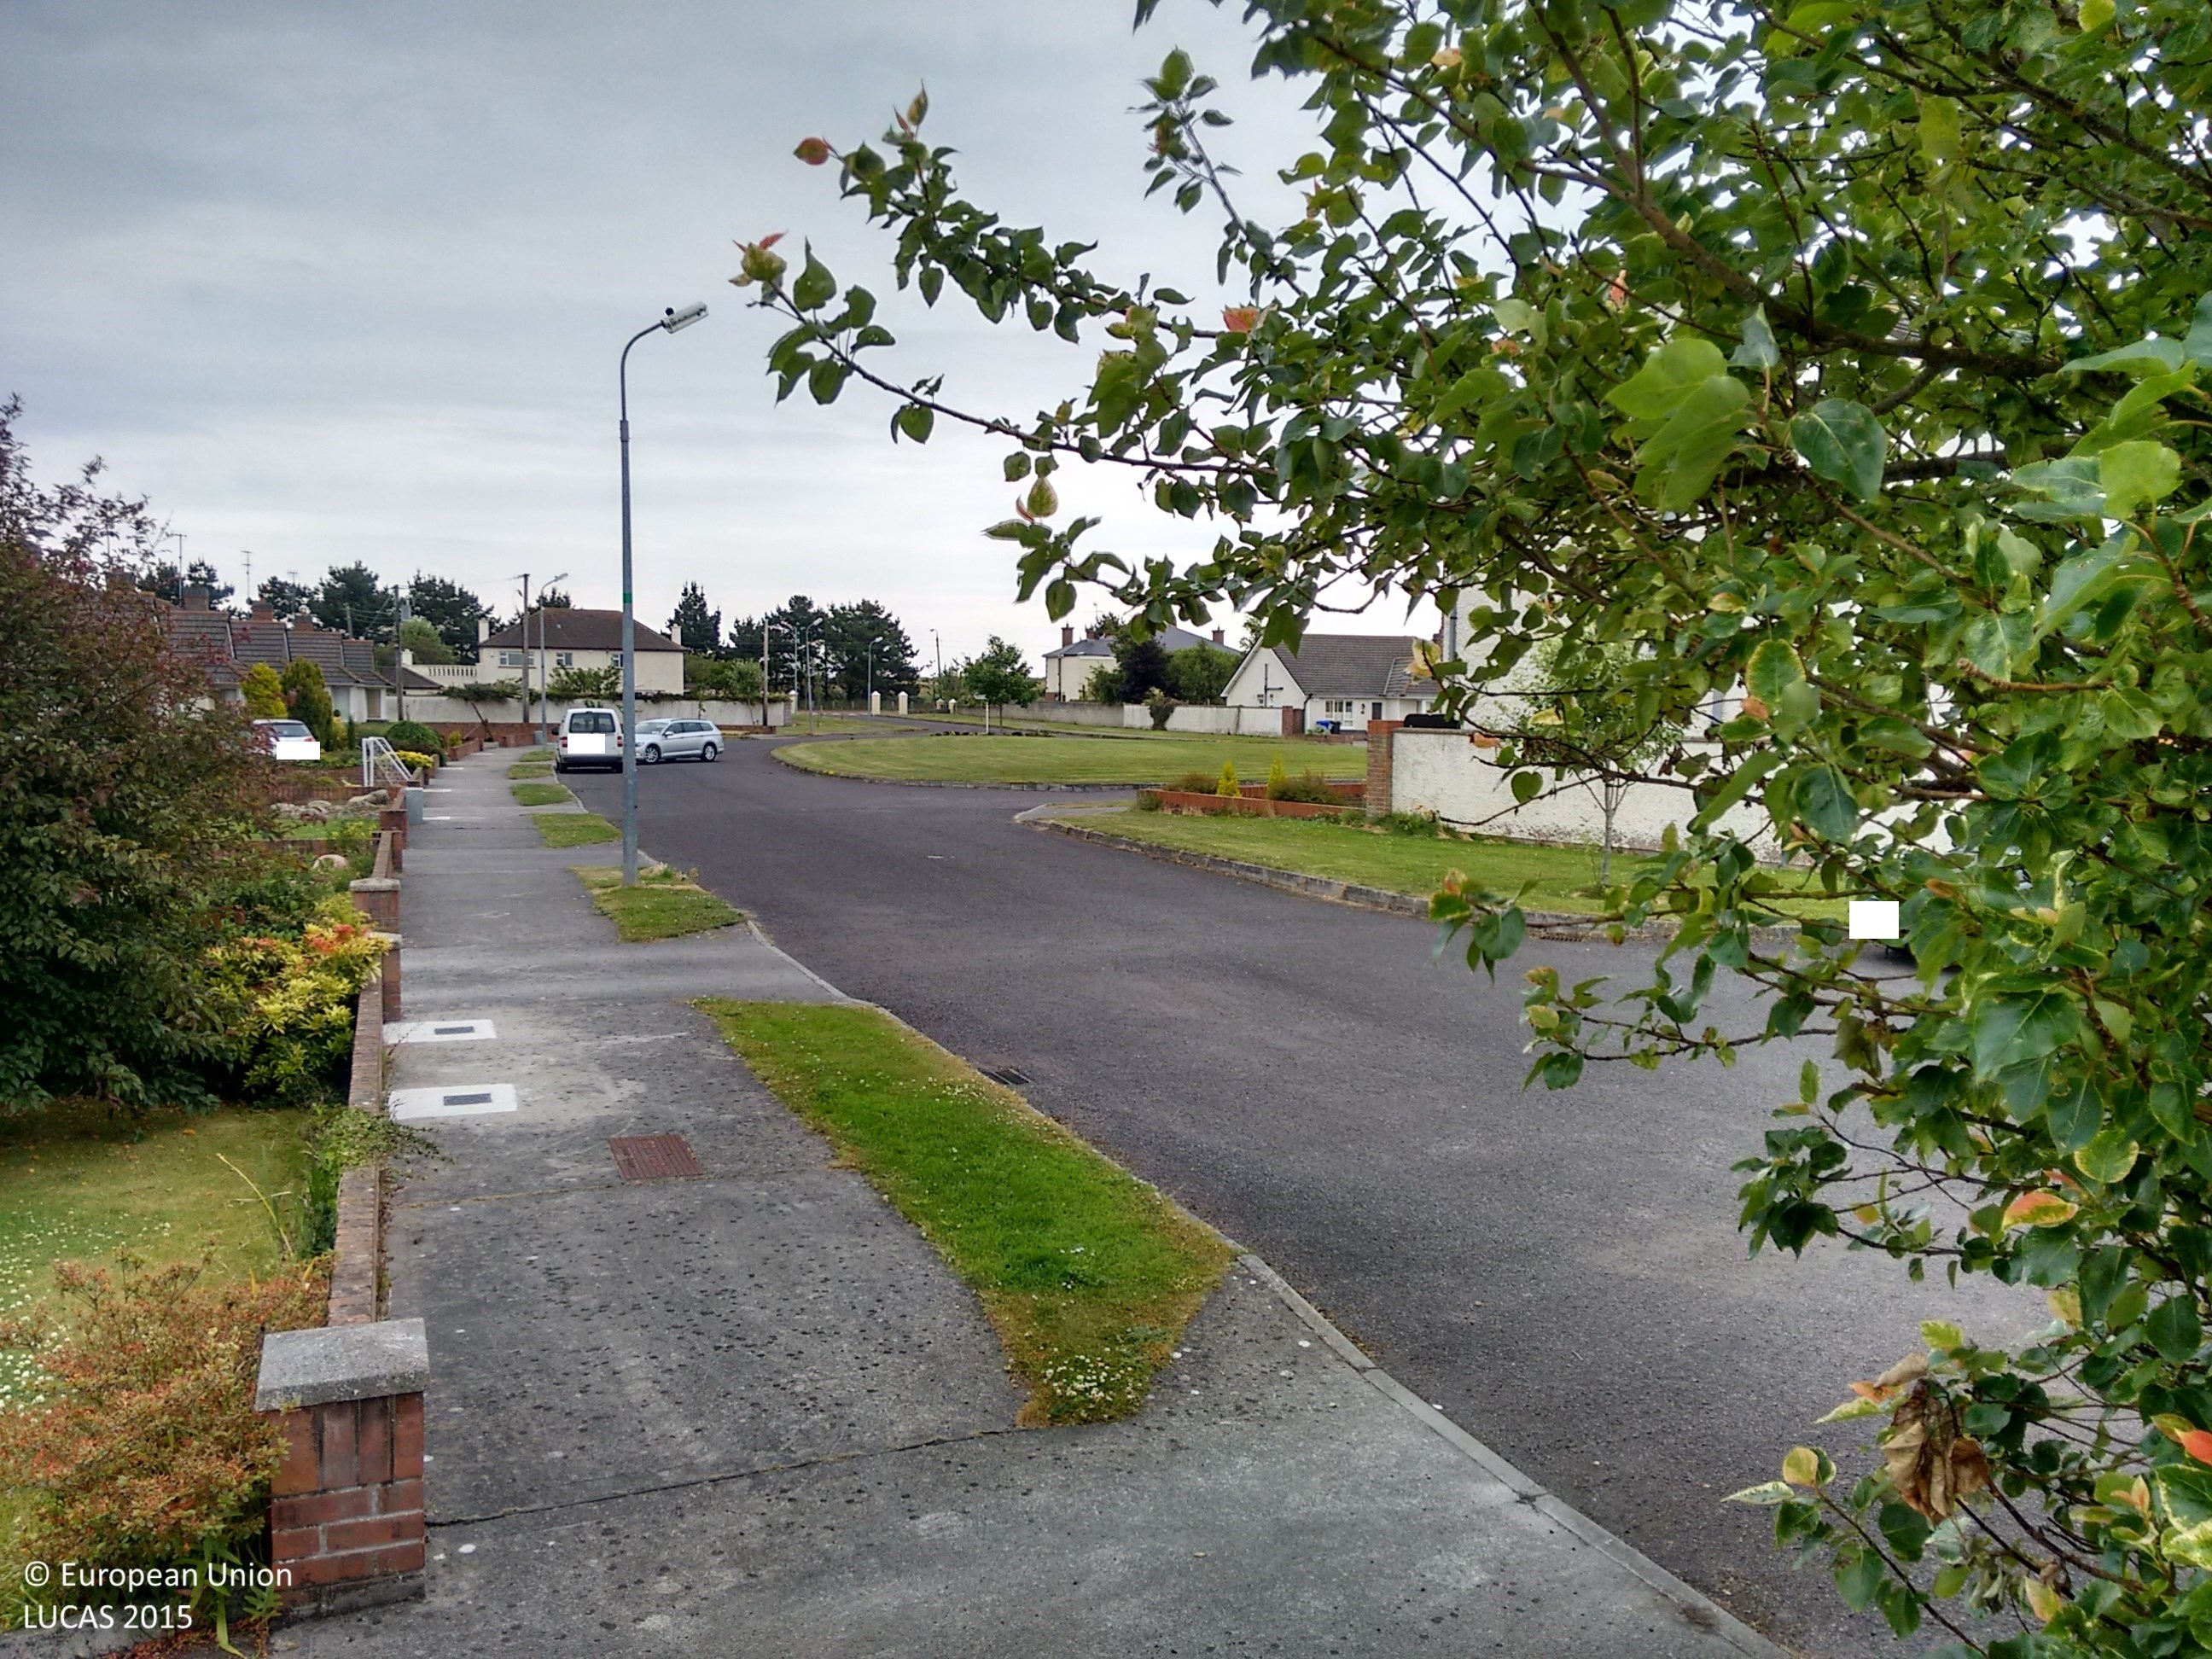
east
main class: Grassland
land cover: Grassland without tree/shrub cover
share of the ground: > 75 %
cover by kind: herbaceous plants 100 %
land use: Agriculture (excluding fallow land and kitchen gardens)
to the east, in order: Grassland without tree/shrub cover; Shrubland without tree cover; Electric lines; Fences; Ditches and canals; Grass margins; Artificial constructions in urban areas
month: June
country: IE
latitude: 53.7074
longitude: -6.2533
